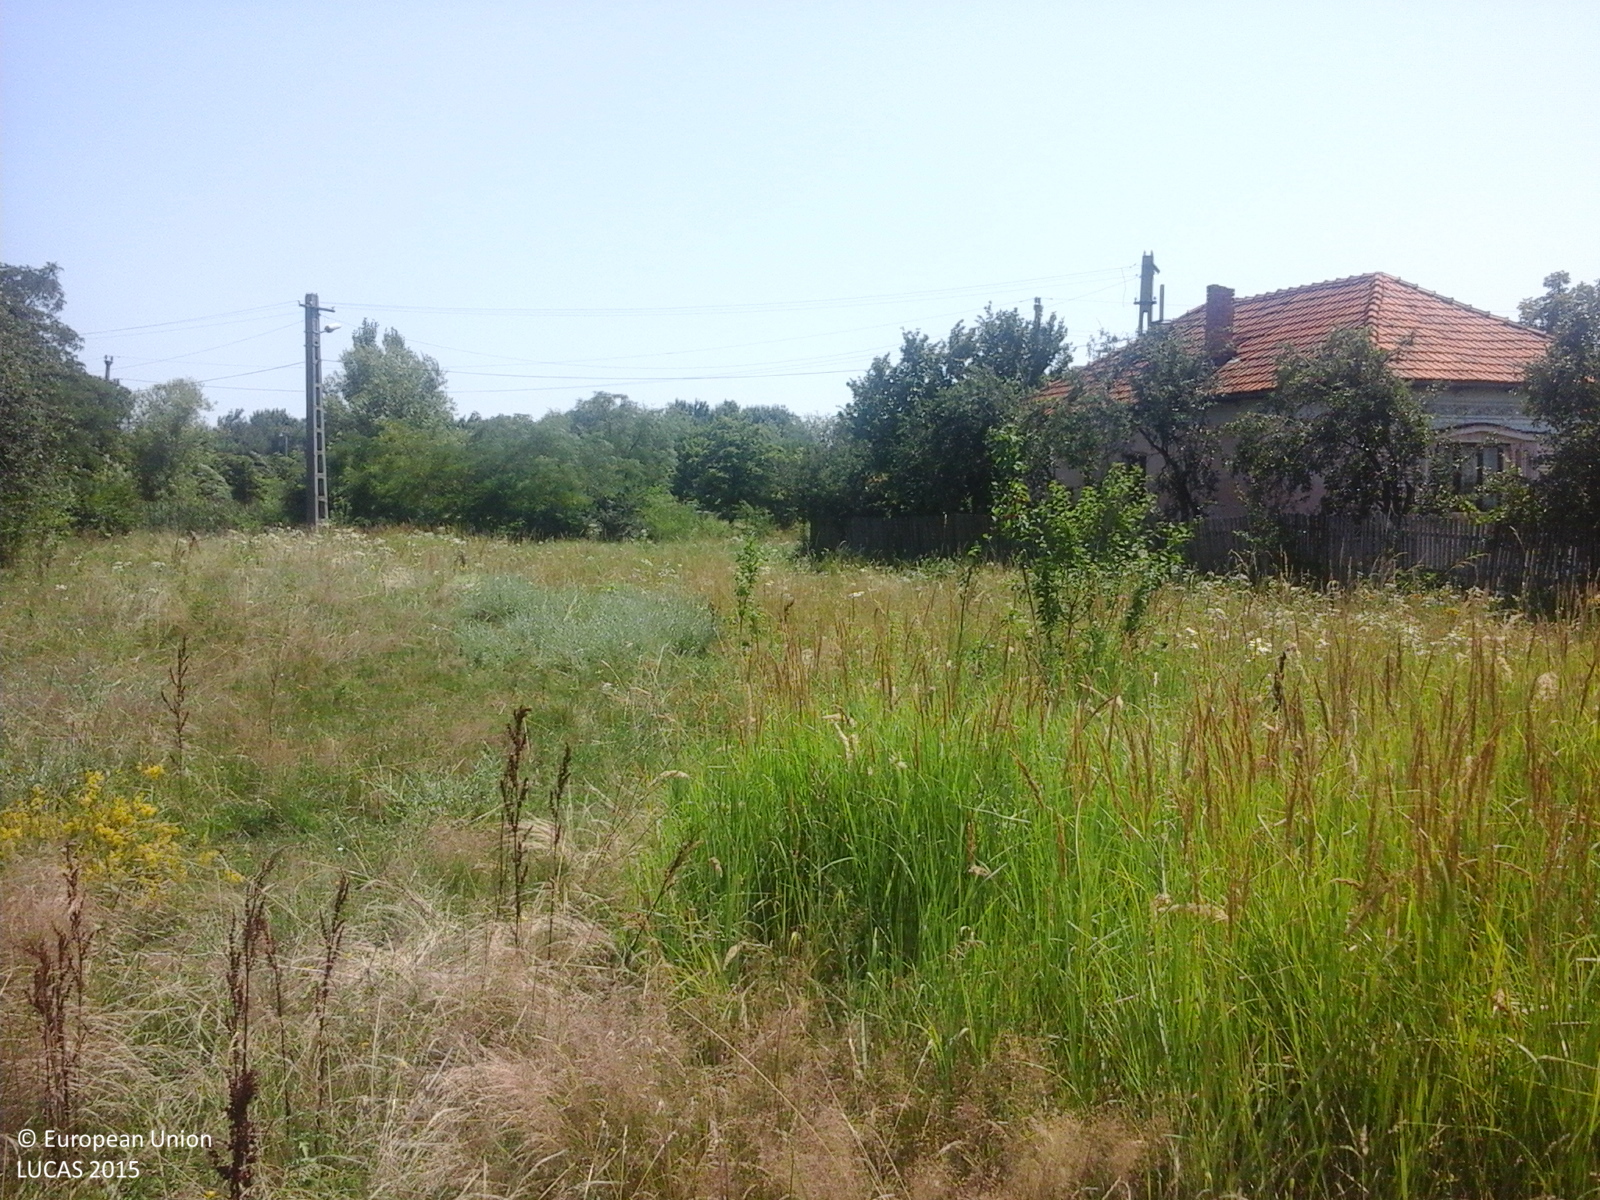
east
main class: Grassland
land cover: Spontaneously vegetated surfaces
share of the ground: > 75 %
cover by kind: herbaceous plants 100 %
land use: Agriculture (excluding fallow land and kitchen gardens)
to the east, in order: Spontaneously vegetated surfaces; Tracks; Grassland with sparse tree/shrub cover; Electric lines; Grassland with sparse tree/shrub cover; Railways; Electric lines; Railways; Artificial constructions; Grass margins; Tracks; Grass margins; Broadleaved woodland; Common wheat; Shrubland without tree cover; Common wheat
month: July
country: RO
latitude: 44.7691
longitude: 24.9026
